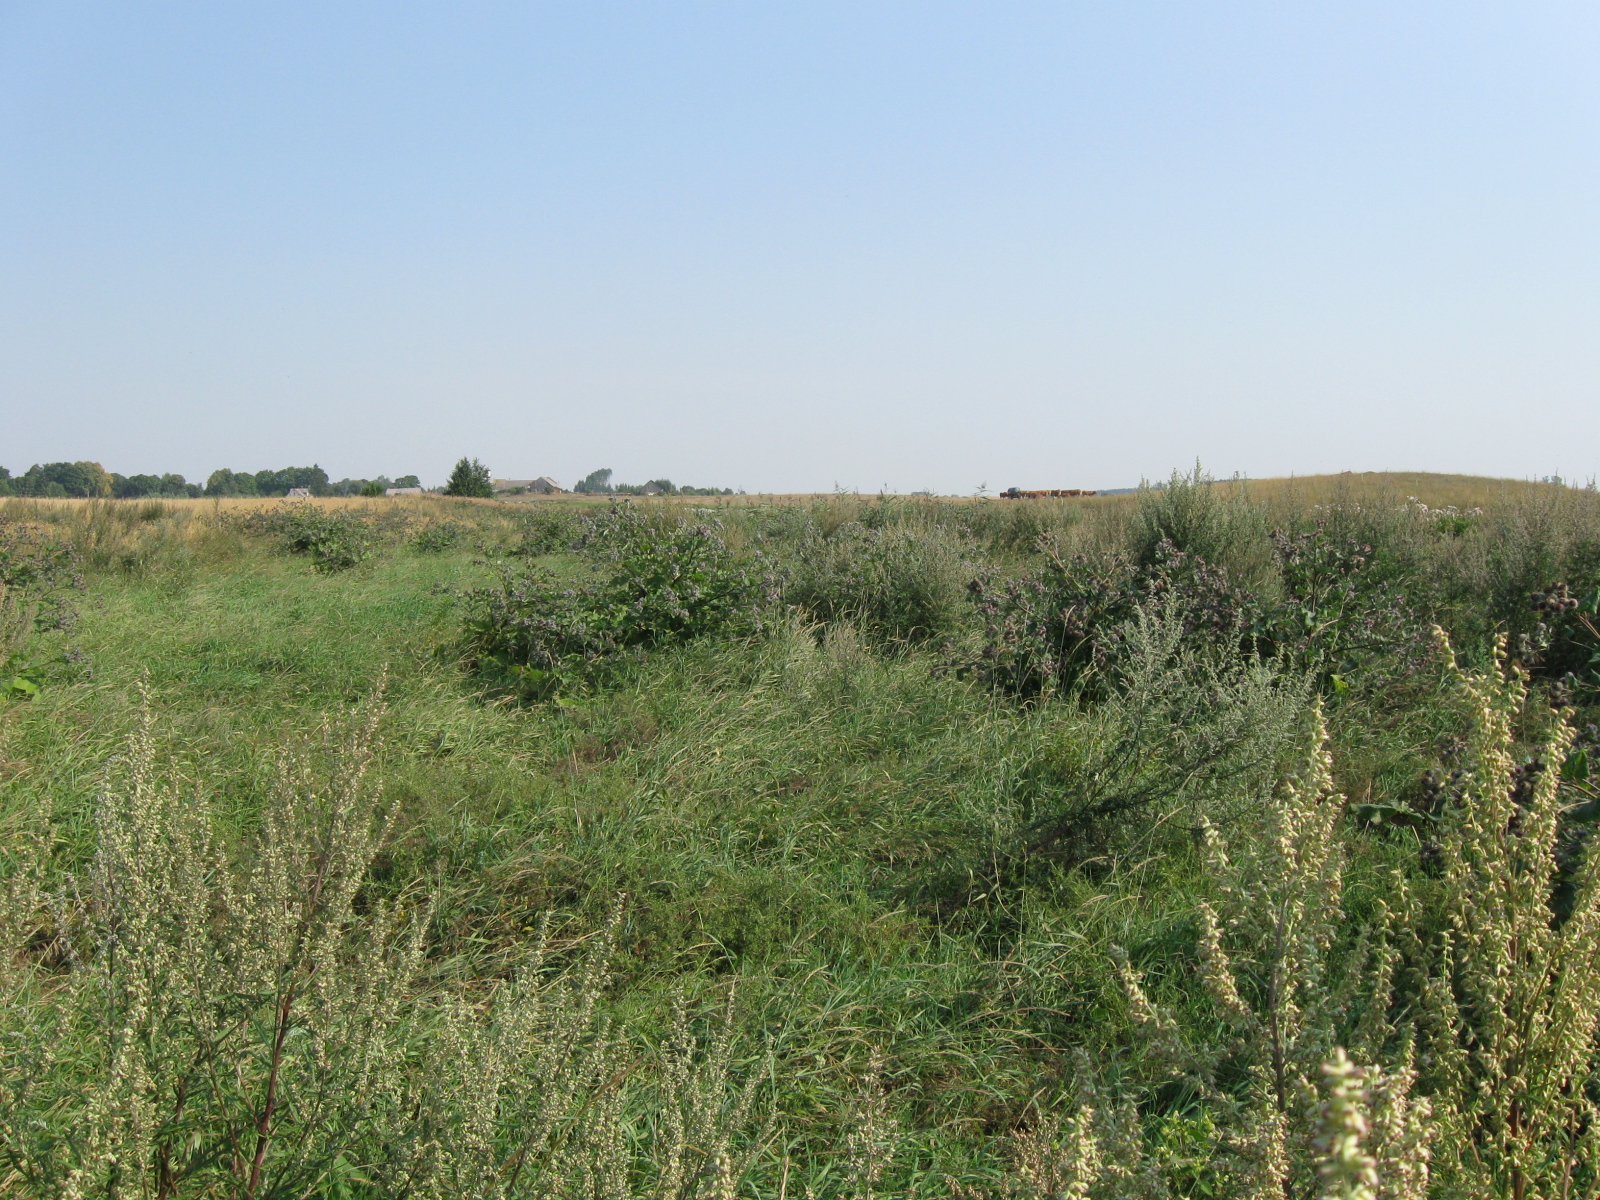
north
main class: Grassland
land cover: Spontaneously vegetated surfaces
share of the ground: > 75 %
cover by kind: herbaceous plants 100 %
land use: Fallow land
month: August
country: LT
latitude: 54.3493
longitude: 23.2311
